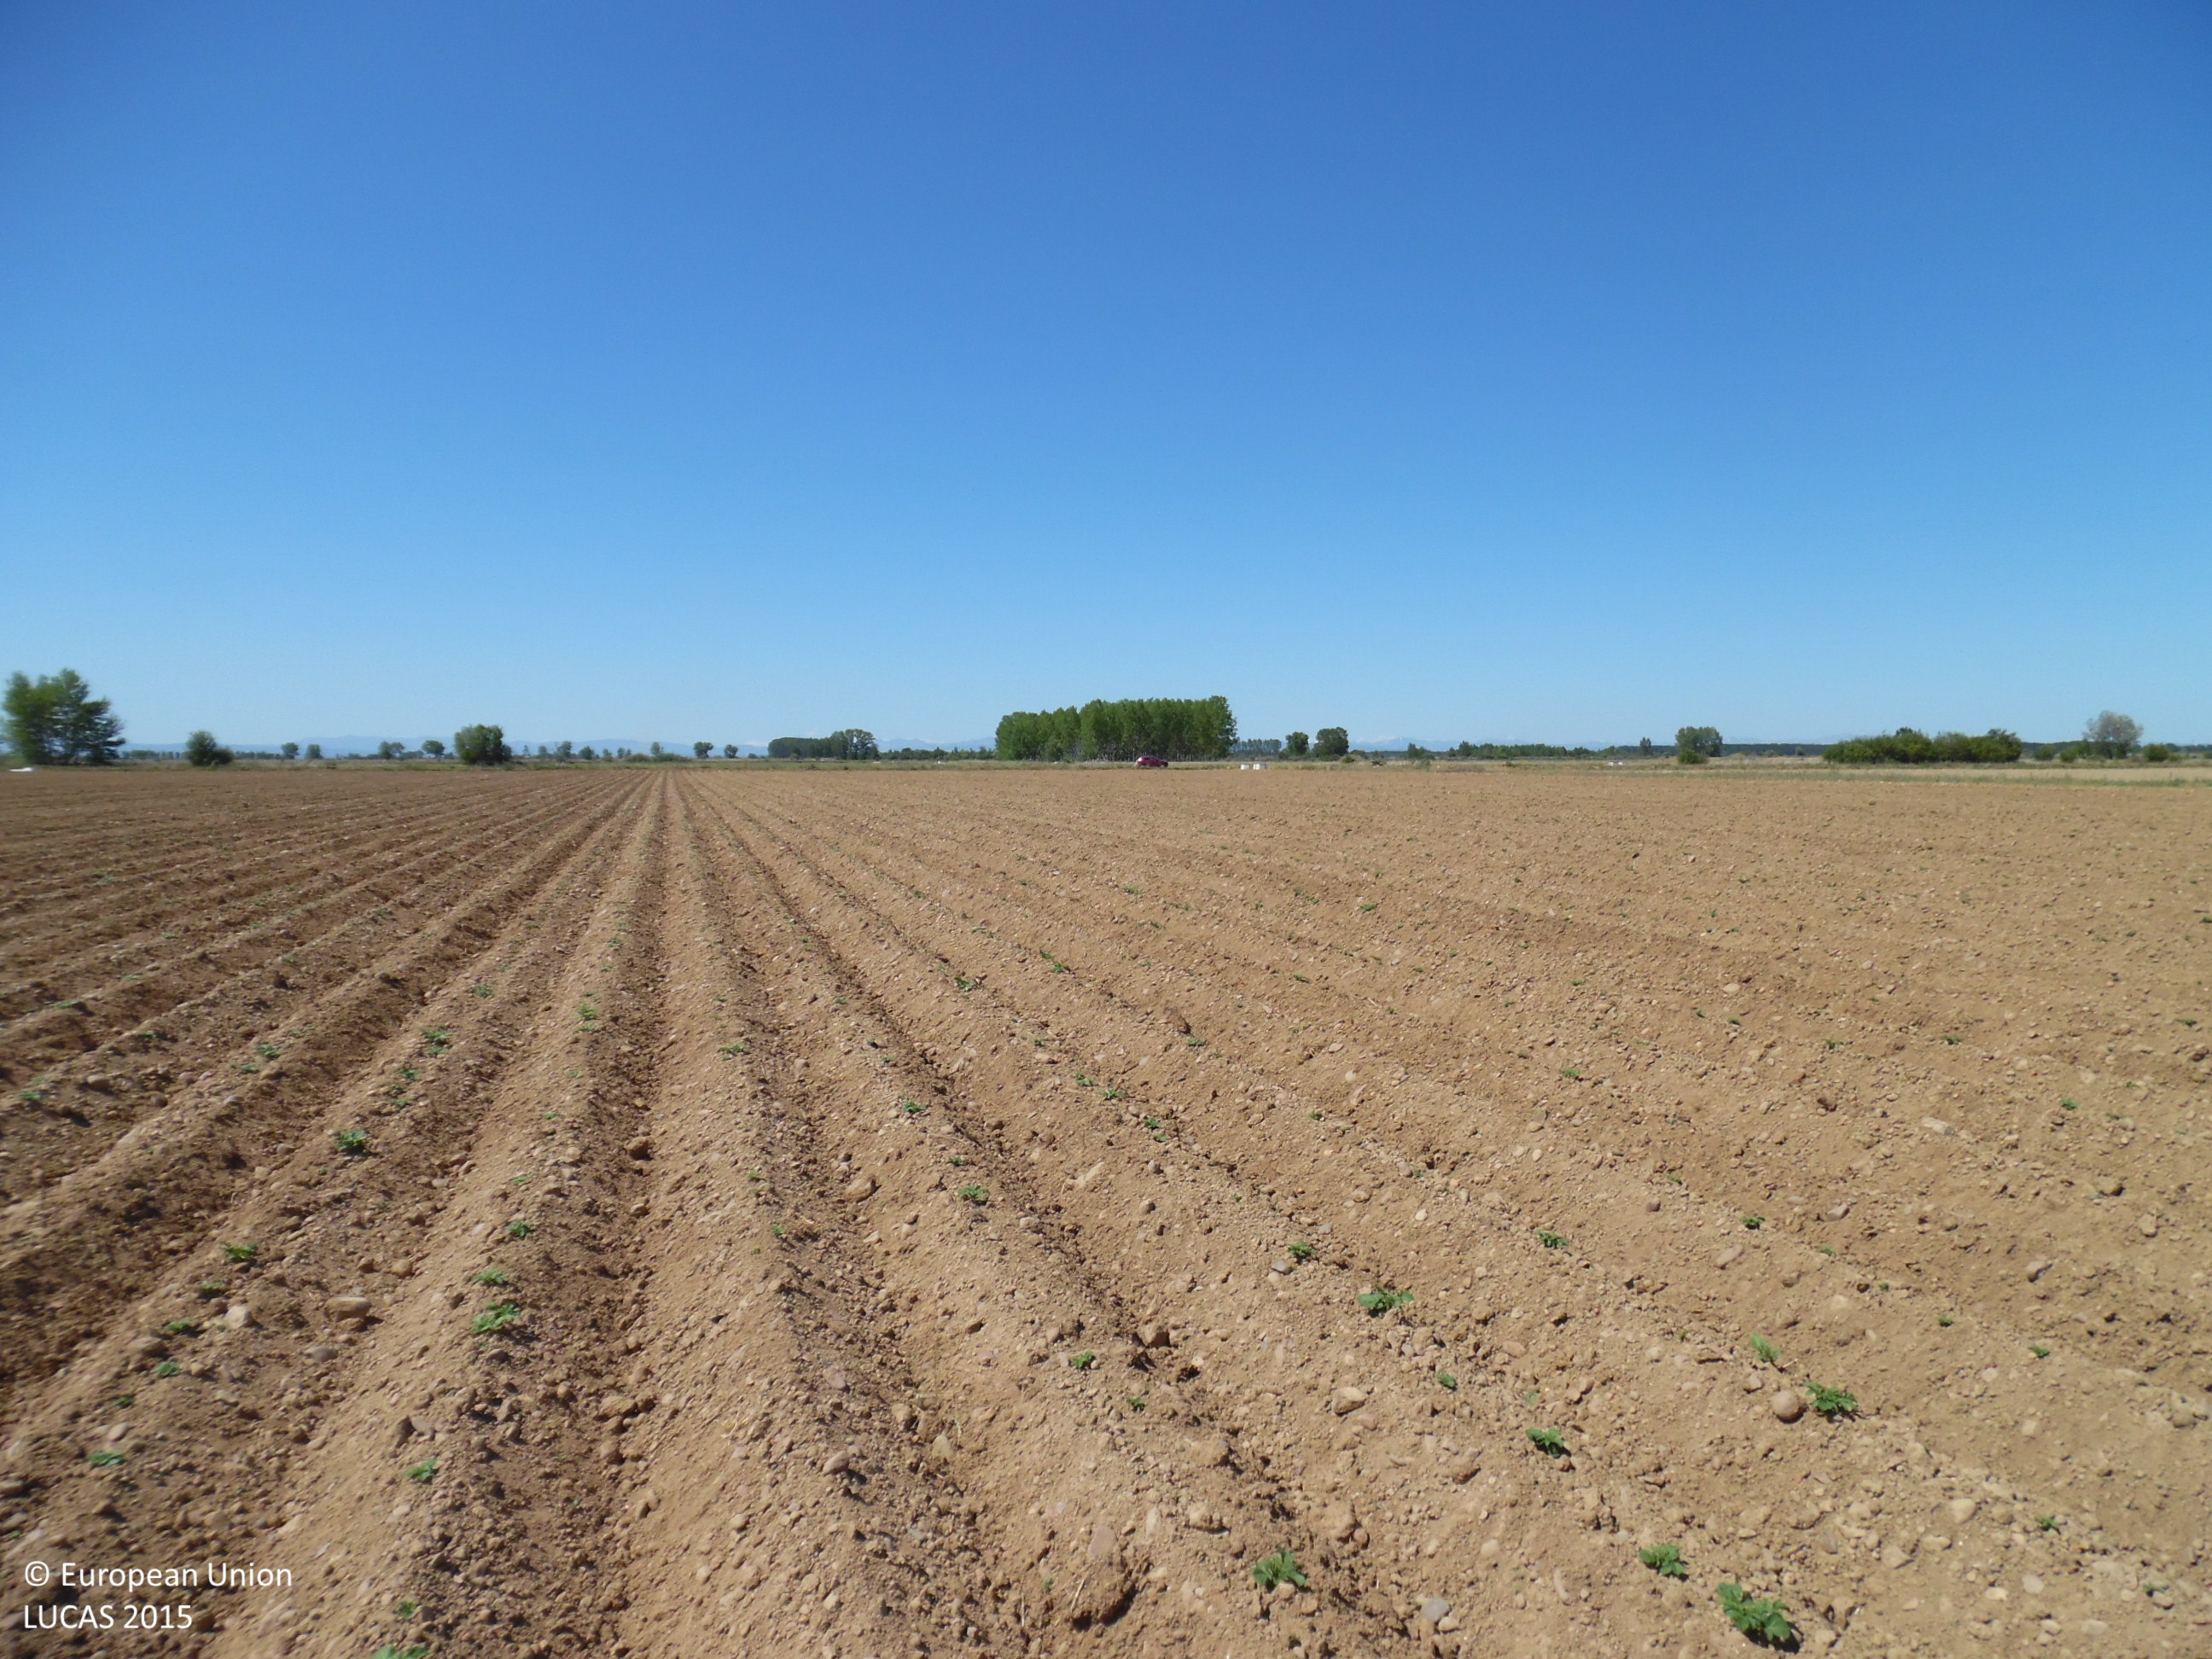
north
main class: Cropland
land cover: Potatoes
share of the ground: < 10 %
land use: Agriculture (excluding fallow land and kitchen gardens)
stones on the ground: 10 - 25 %
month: June
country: ES
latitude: 42.4280
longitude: -5.7168
